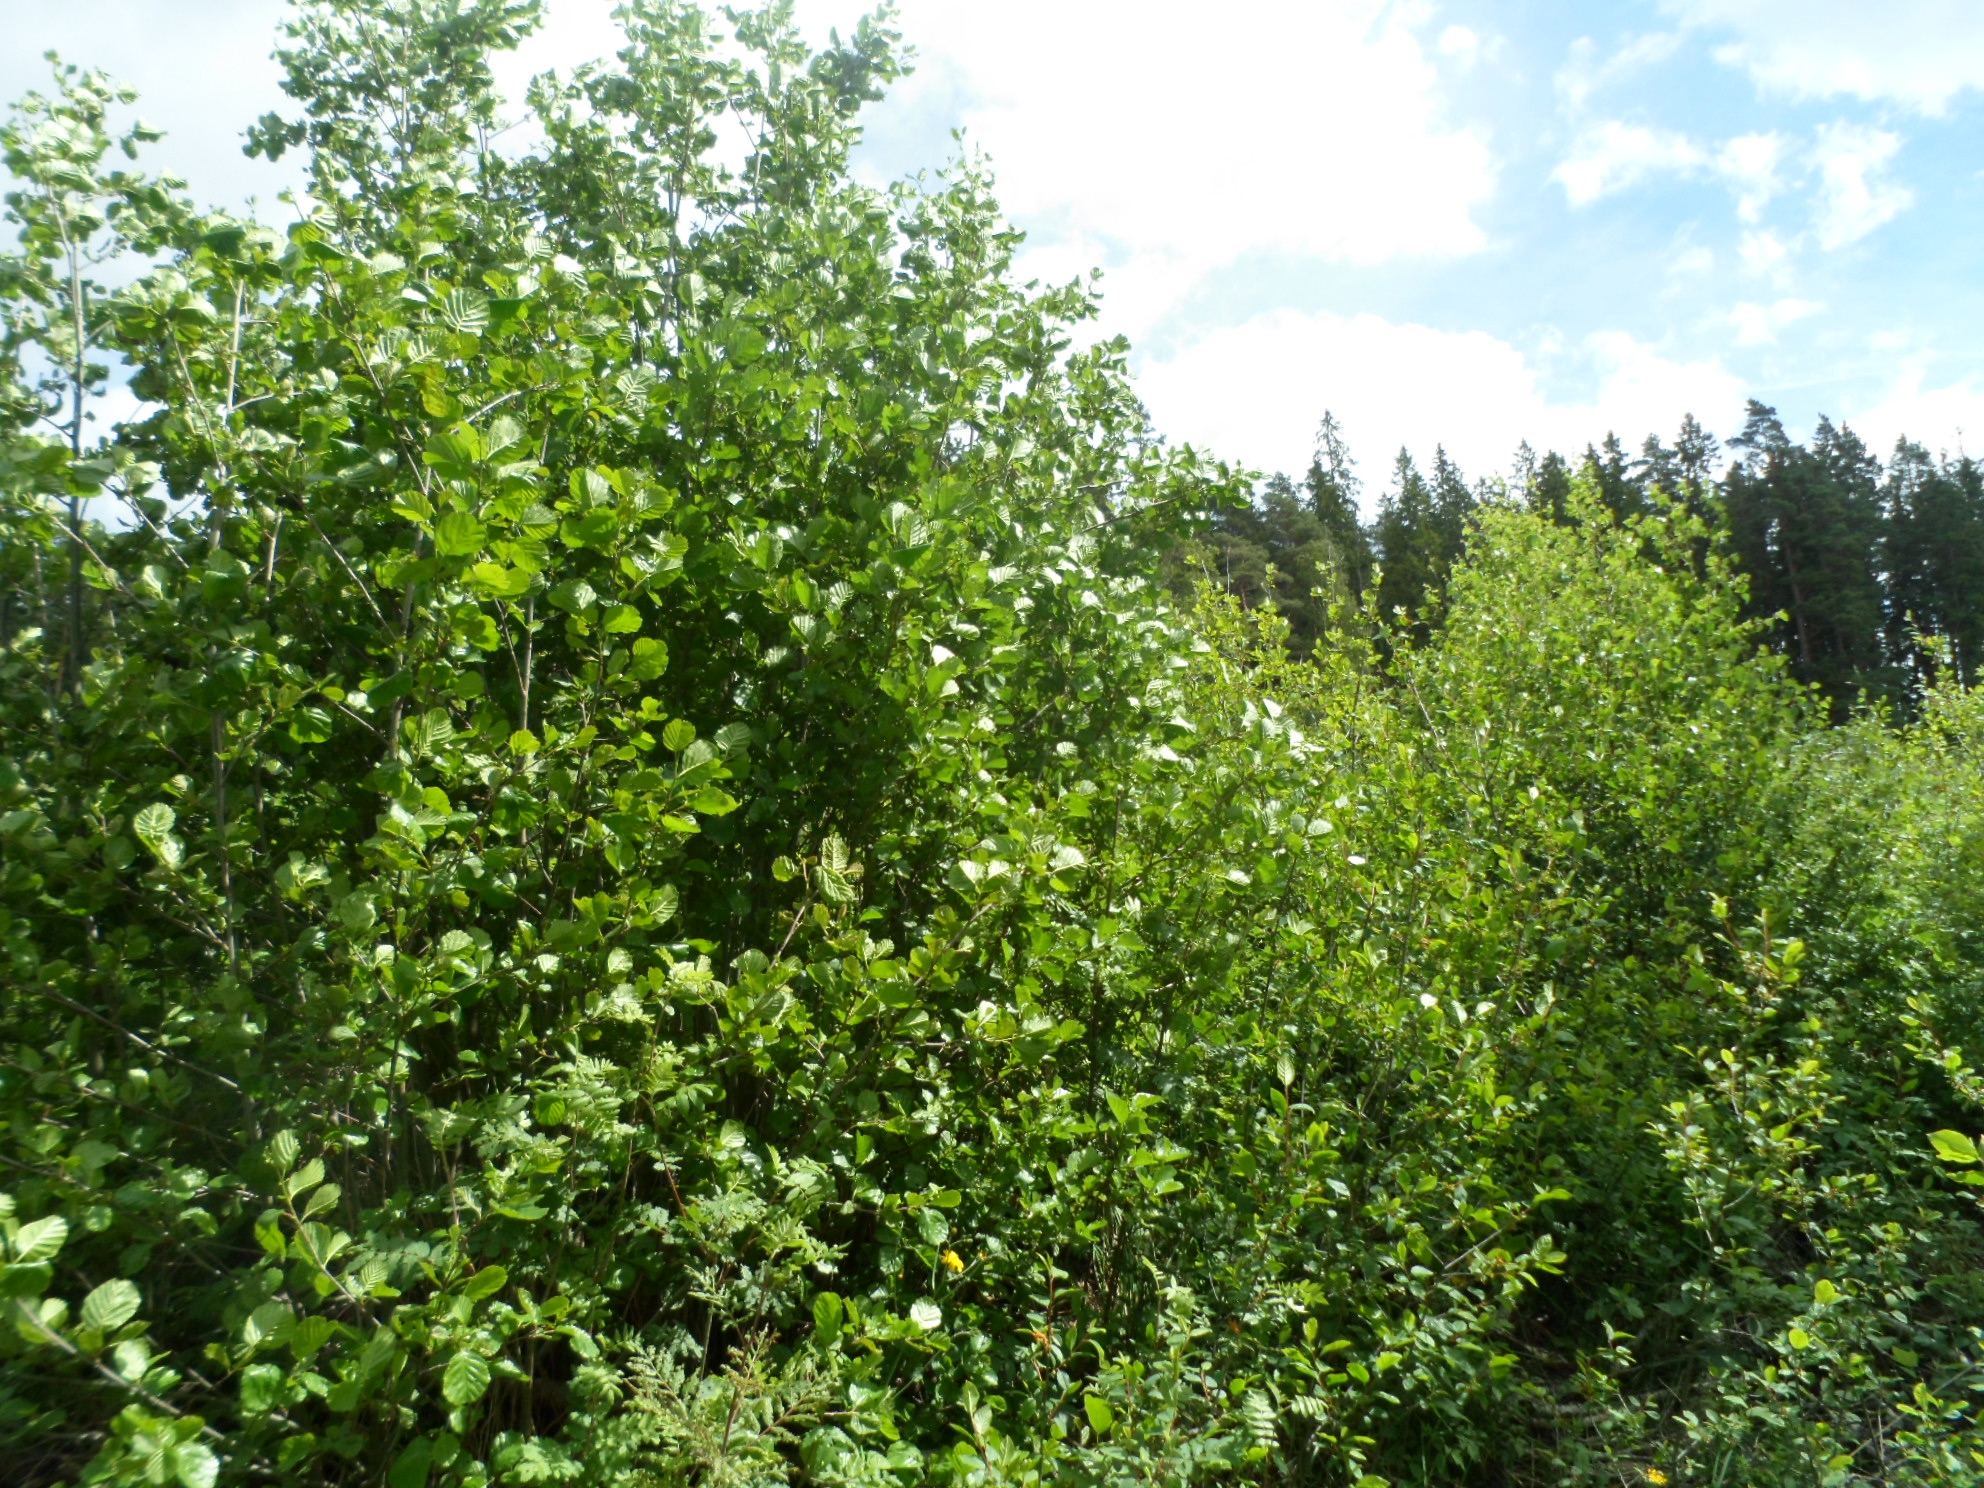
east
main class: Woodland
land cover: Broadleaved woodland
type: hemiboreal forest and nemoral coniferous forest and mixed broadleaved-coniferous forest
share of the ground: 25 - 50 %
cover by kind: shrubs 40 %, herbaceous plants 30 %, broadleaved forest trees 25 %, lichens and mosses 5 %
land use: Forestry
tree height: > 5 m
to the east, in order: Broadleaved woodland; Grassland without tree/shrub cover; Groves; Spruce dominated coniferous woodland; Pine dominated coniferous woodland
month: June
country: SE
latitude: 57.1247
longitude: 14.8034
